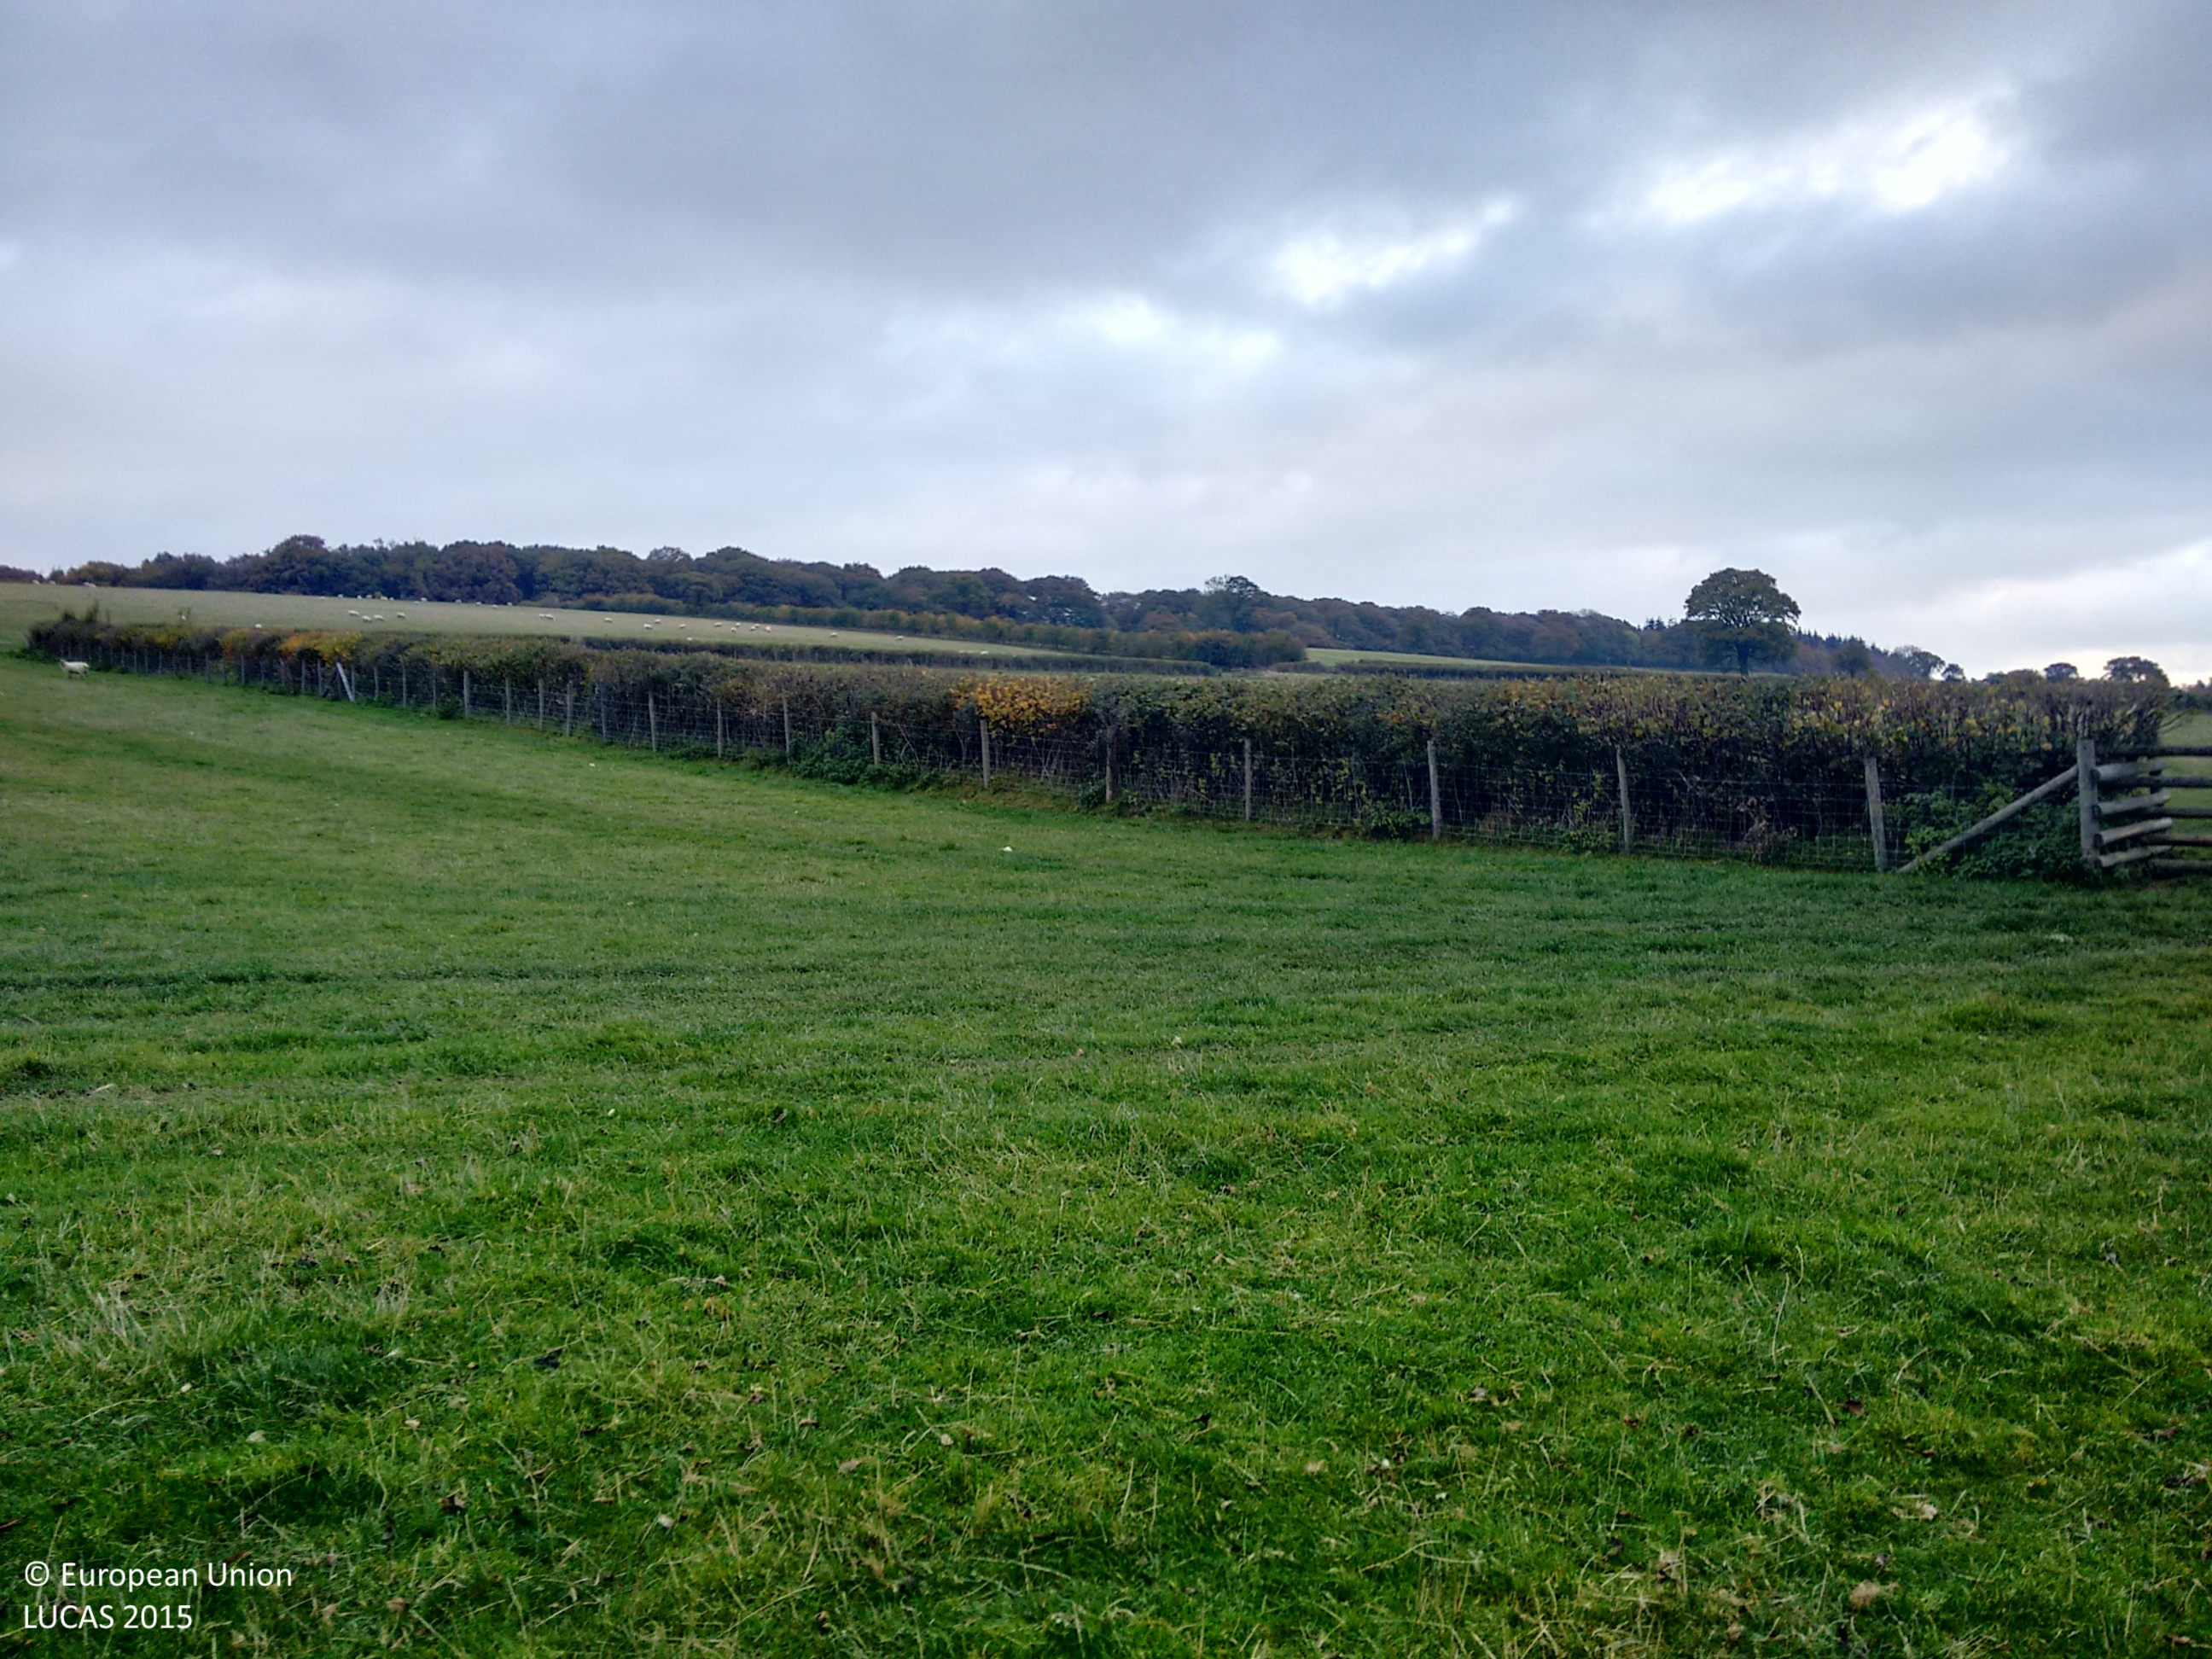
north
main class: Grassland
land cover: Grassland without tree/shrub cover
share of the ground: > 75 %
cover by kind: herbaceous plants 100 %
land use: Agriculture (excluding fallow land and kitchen gardens)
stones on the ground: < 10 %
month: October
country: GB
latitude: 52.4877
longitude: -2.7502
